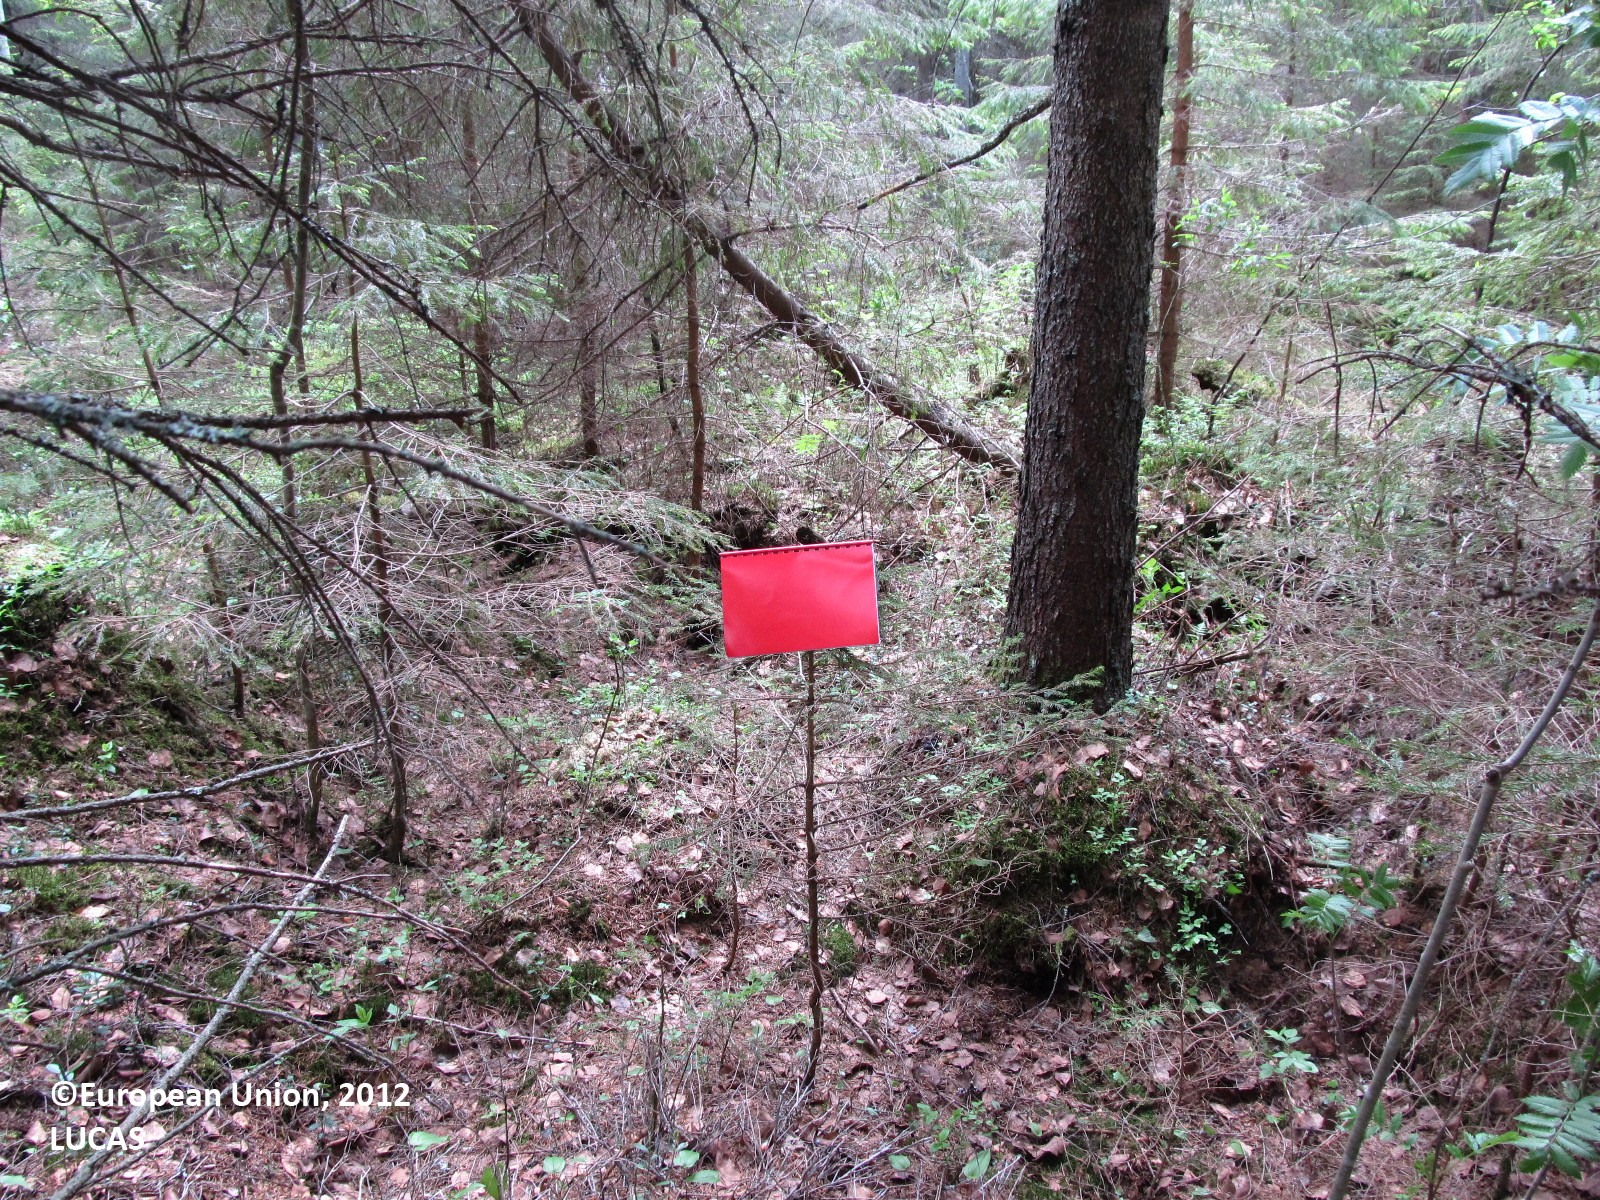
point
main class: Woodland
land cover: Spruce dominated coniferous woodland
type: boreal forest
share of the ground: 50 - 75 %
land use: Forestry
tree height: > 5 m
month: June
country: FI
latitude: 62.5113
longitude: 29.0795
